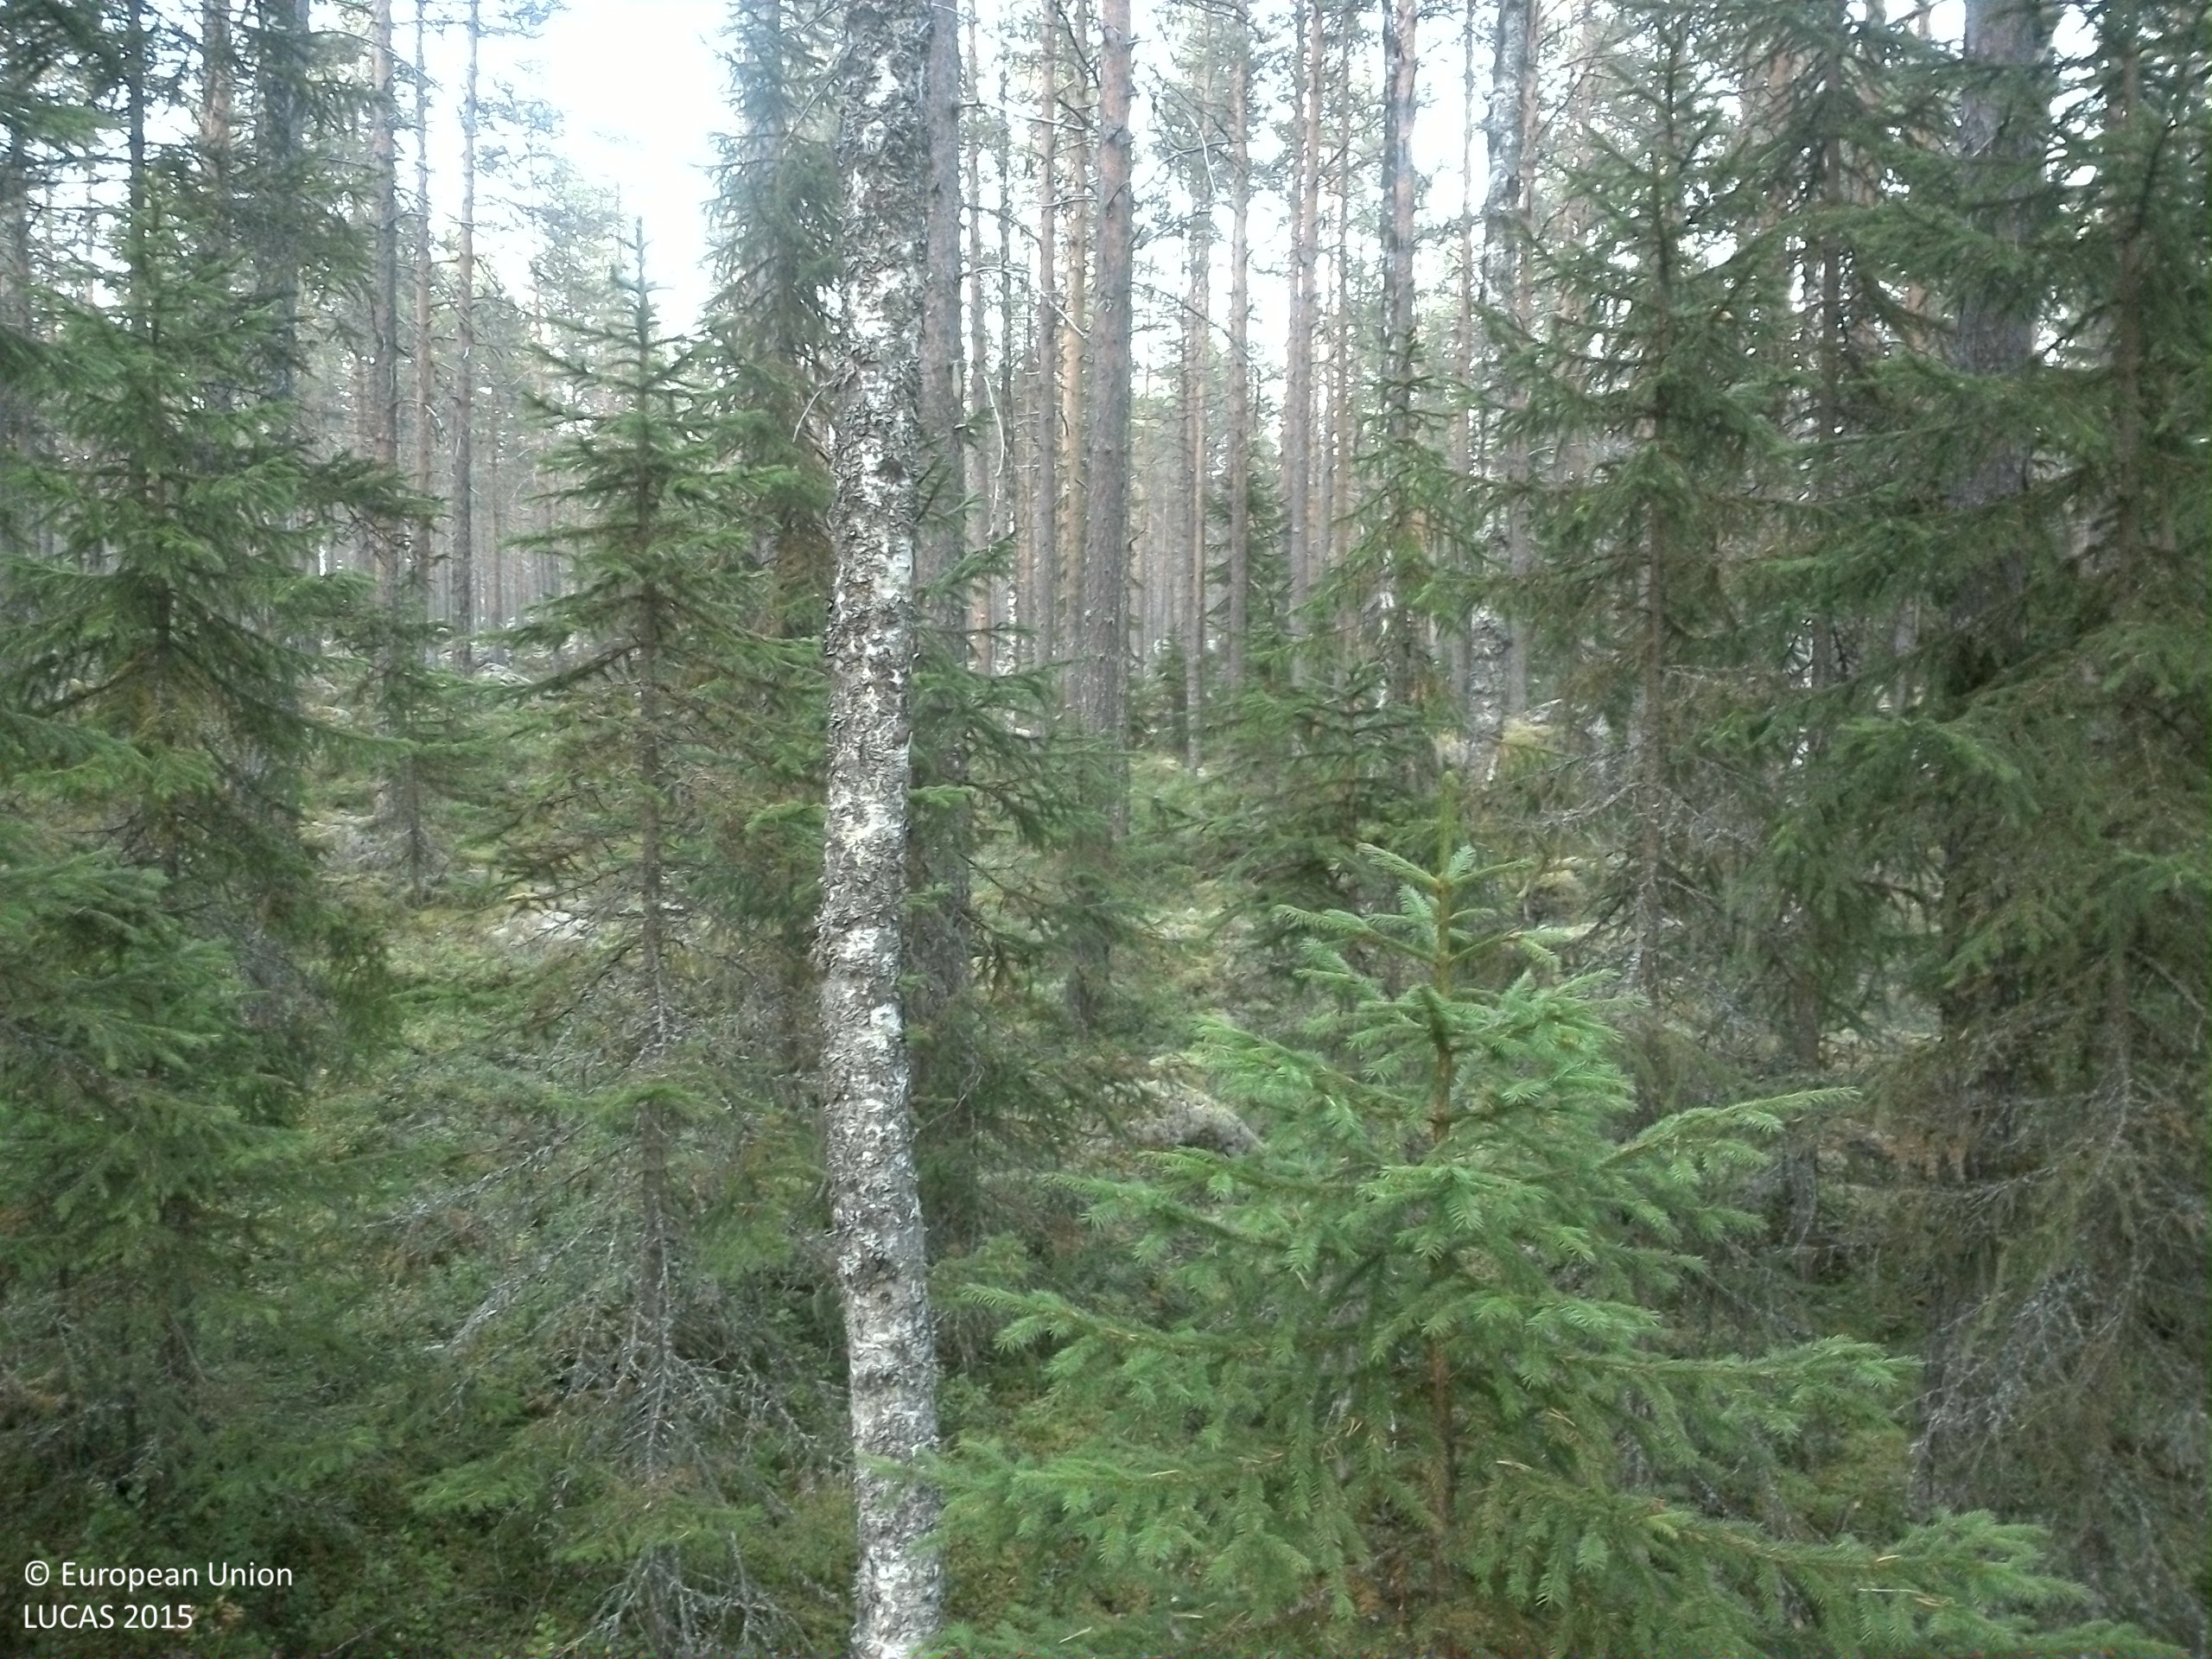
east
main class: Woodland
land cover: Pine dominated coniferous woodland
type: boreal forest
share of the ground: > 75 %
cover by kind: coniferous forest trees 75 %, shrubs 10 %, lichens and mosses 10 %, broadleaved forest trees 5 %
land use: Forestry
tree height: > 5 m
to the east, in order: Pine dominated coniferous woodland
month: September
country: SE
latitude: 61.6288
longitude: 15.4354
